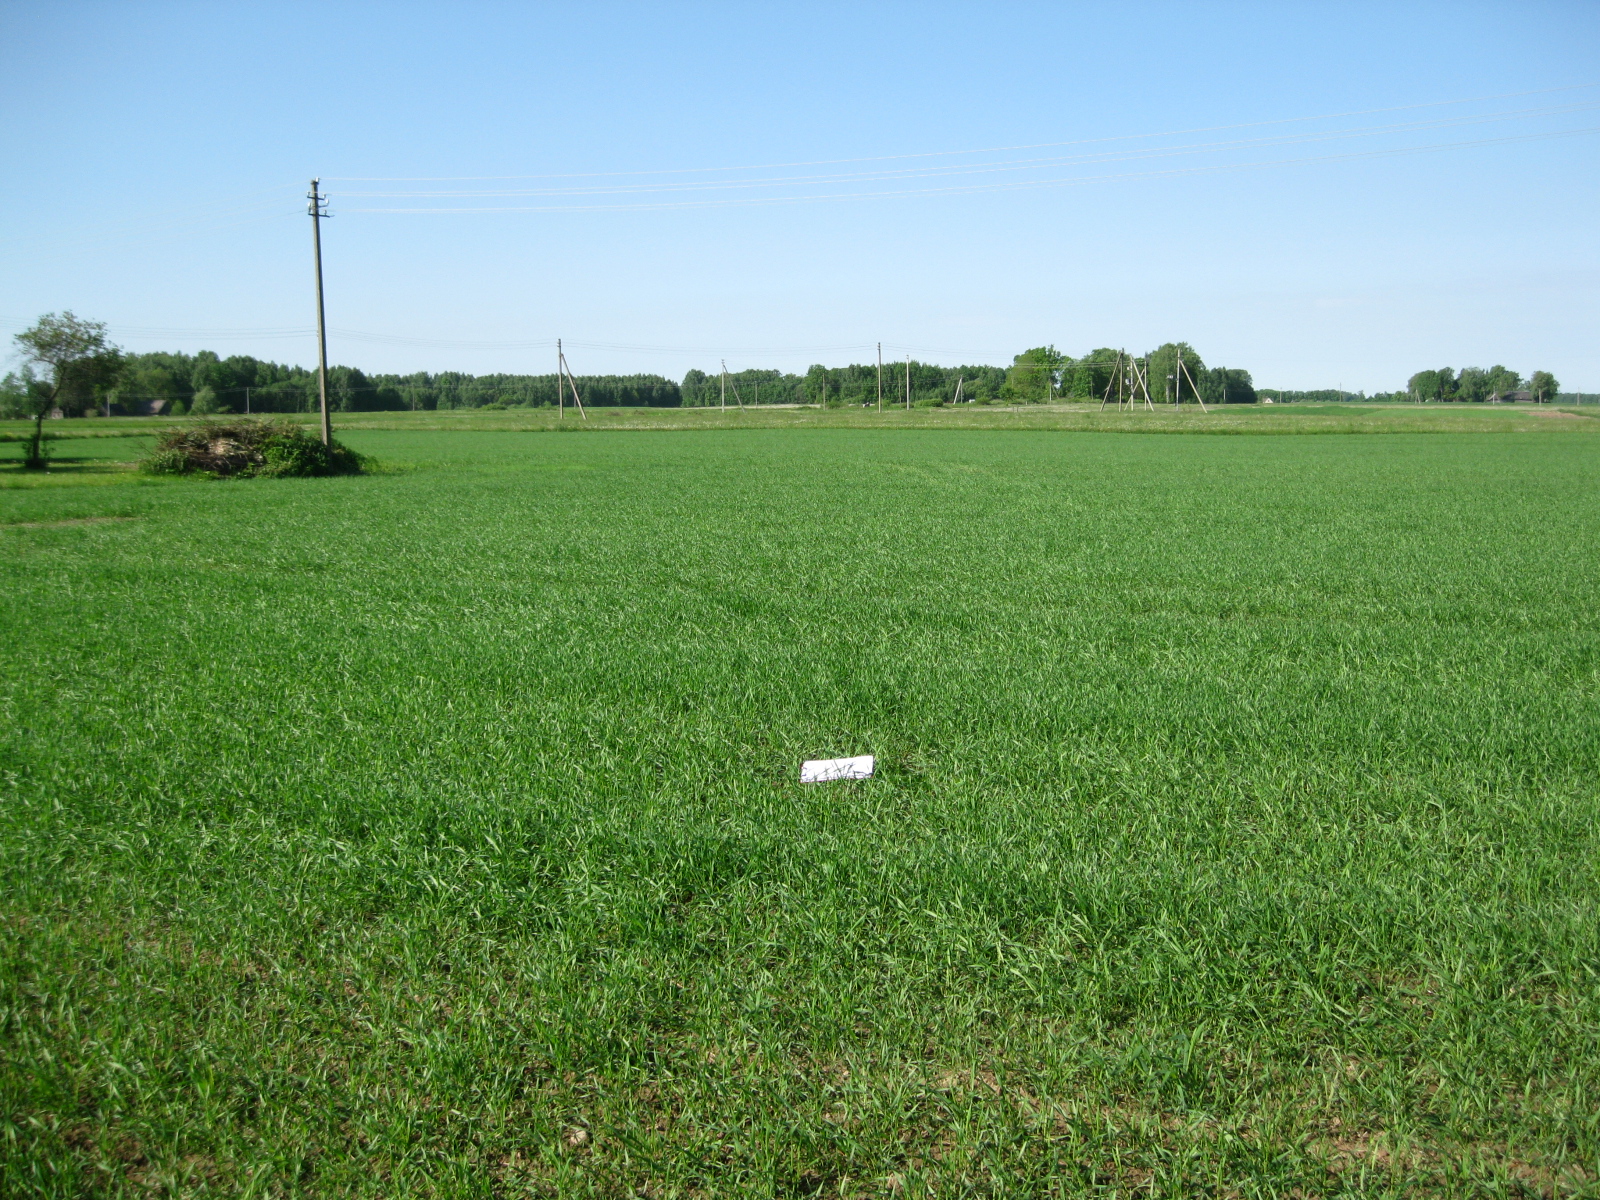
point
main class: Cropland
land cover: Common wheat
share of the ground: > 75 %
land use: Agriculture (excluding fallow land and kitchen gardens)
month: May
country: LT
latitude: 55.8656
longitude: 24.8558
